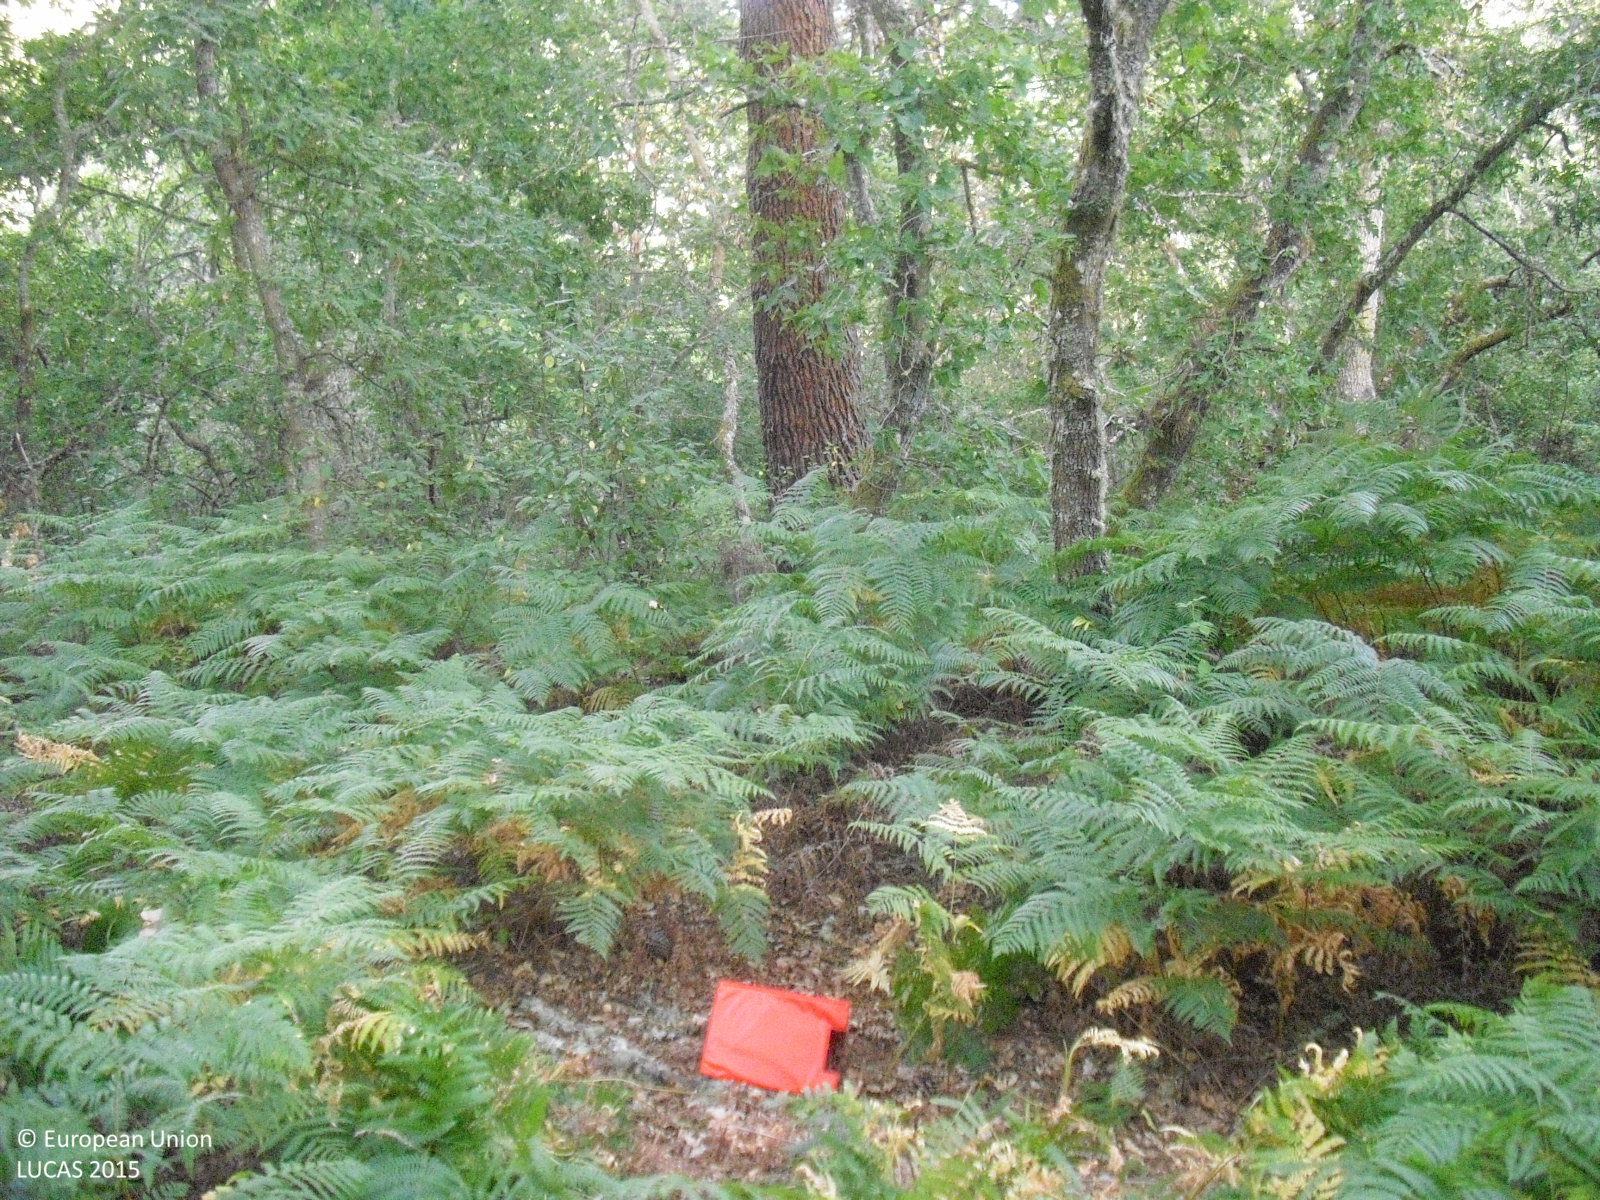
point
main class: Woodland
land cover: Pine dominated mixed woodland
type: hemiboreal forest and nemoral coniferous forest and mixed broadleaved-coniferous forest
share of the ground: > 75 %
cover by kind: broadleaved forest trees 60 %, coniferous forest trees 20 %, shrubs 20 %
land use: Forestry
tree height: > 5 m
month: July
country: ES
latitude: 42.3075
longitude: -7.7488
